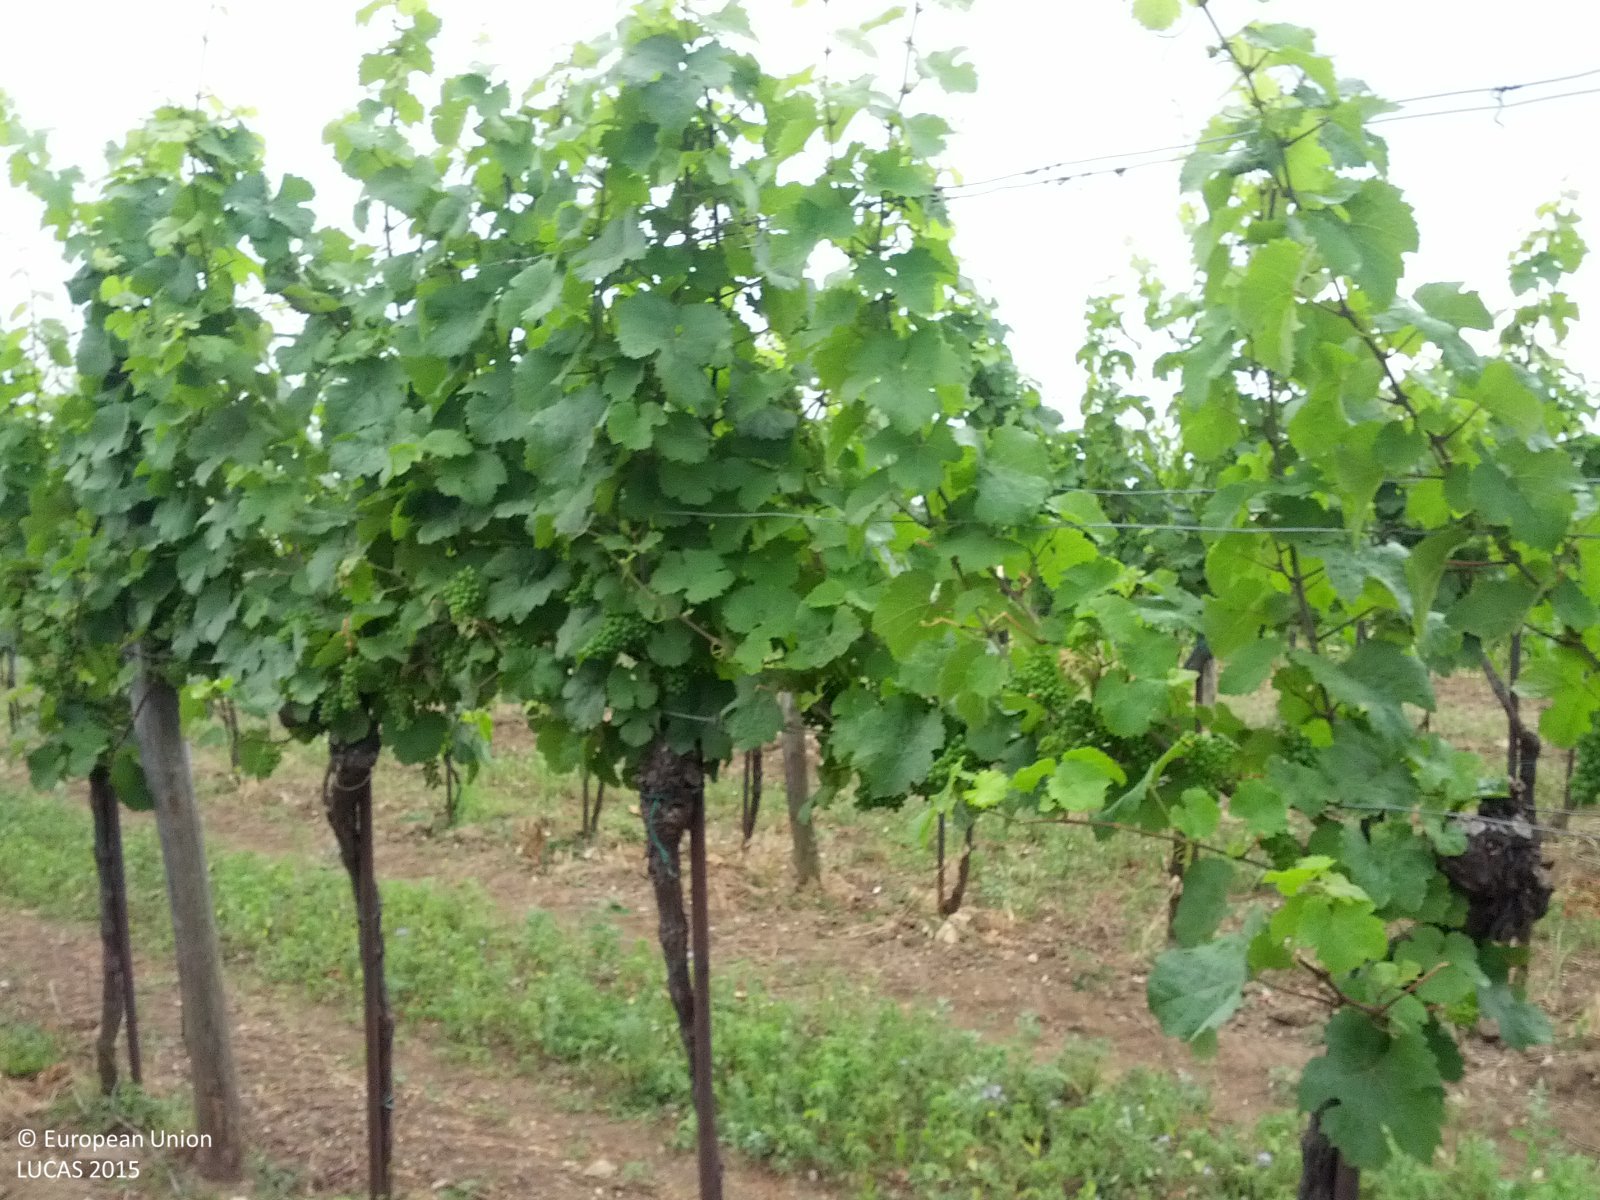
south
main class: Cropland
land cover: Vineyards
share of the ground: 25 - 50 %
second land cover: Grassland without tree/shrub cover
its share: 50 - 75 %
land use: Agriculture (excluding fallow land and kitchen gardens)
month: July
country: AT
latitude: 48.7460
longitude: 16.6300
